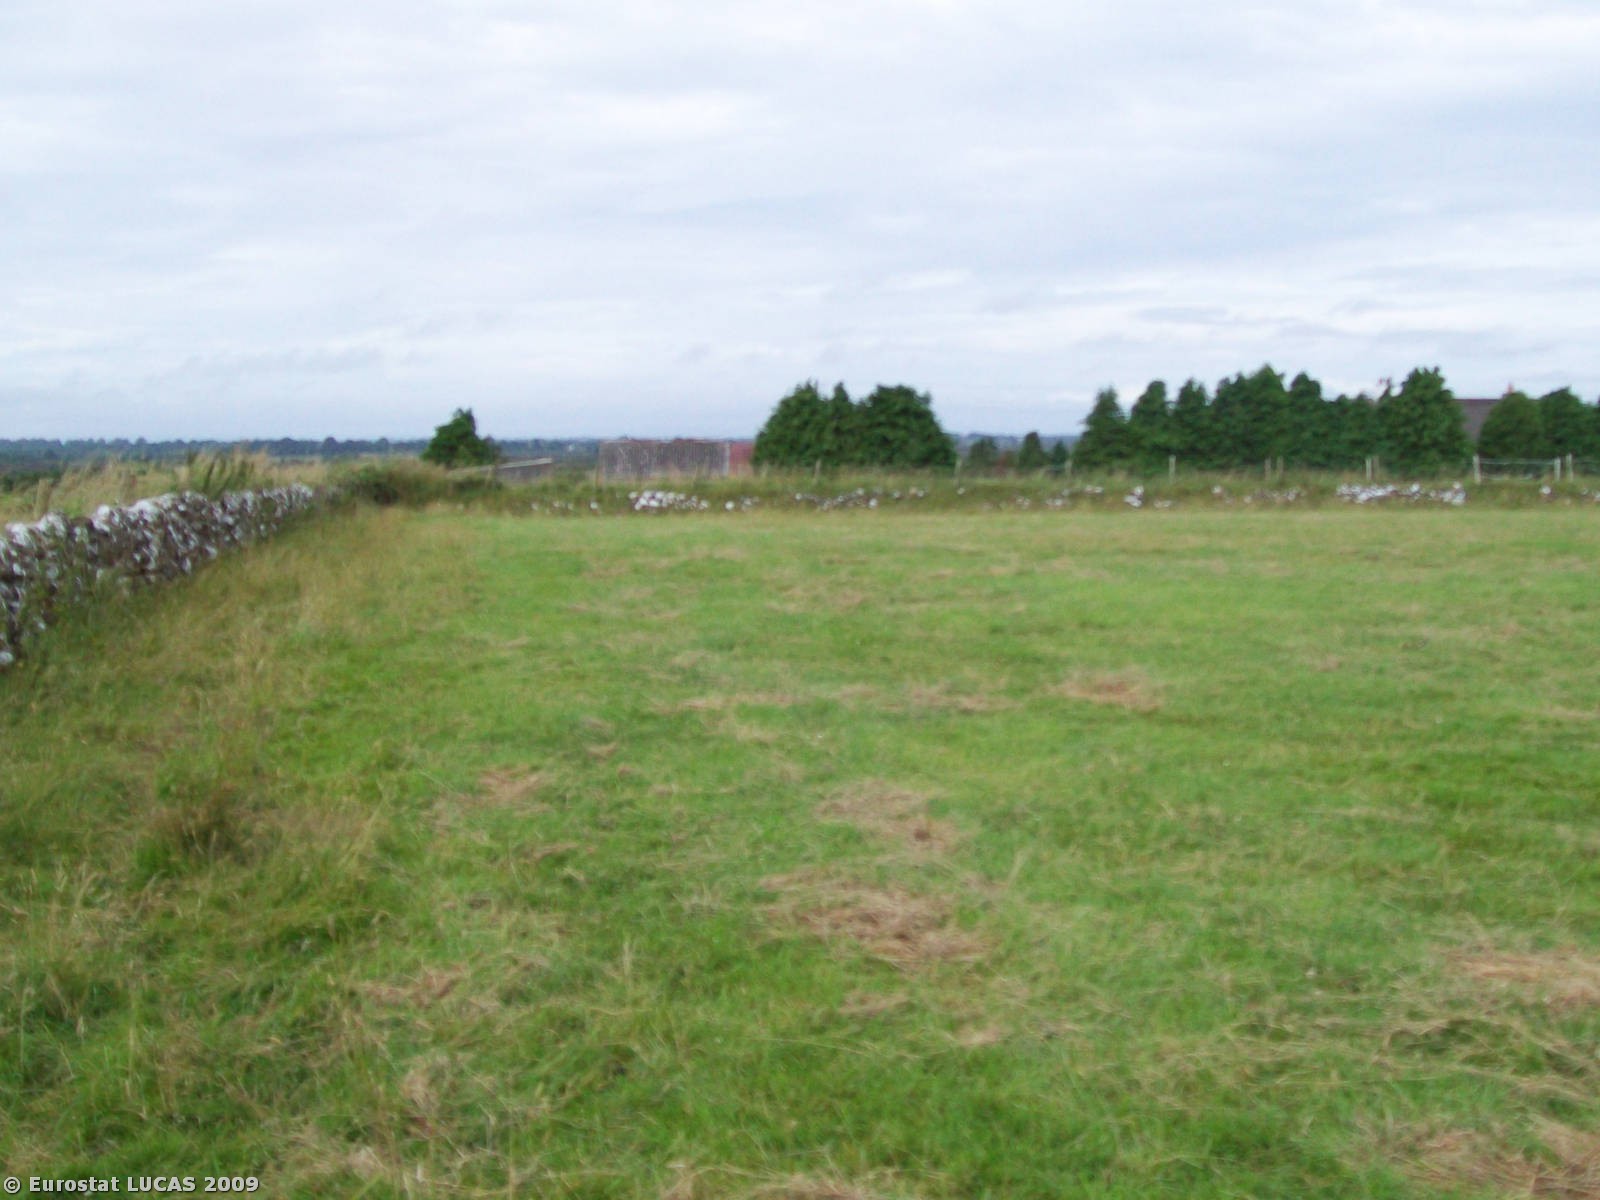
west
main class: Grassland
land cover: Grassland without tree/shrub cover
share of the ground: > 75 %
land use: Agriculture (excluding fallow land and kitchen gardens)
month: July
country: IE
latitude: 53.5046
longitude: -8.8885
